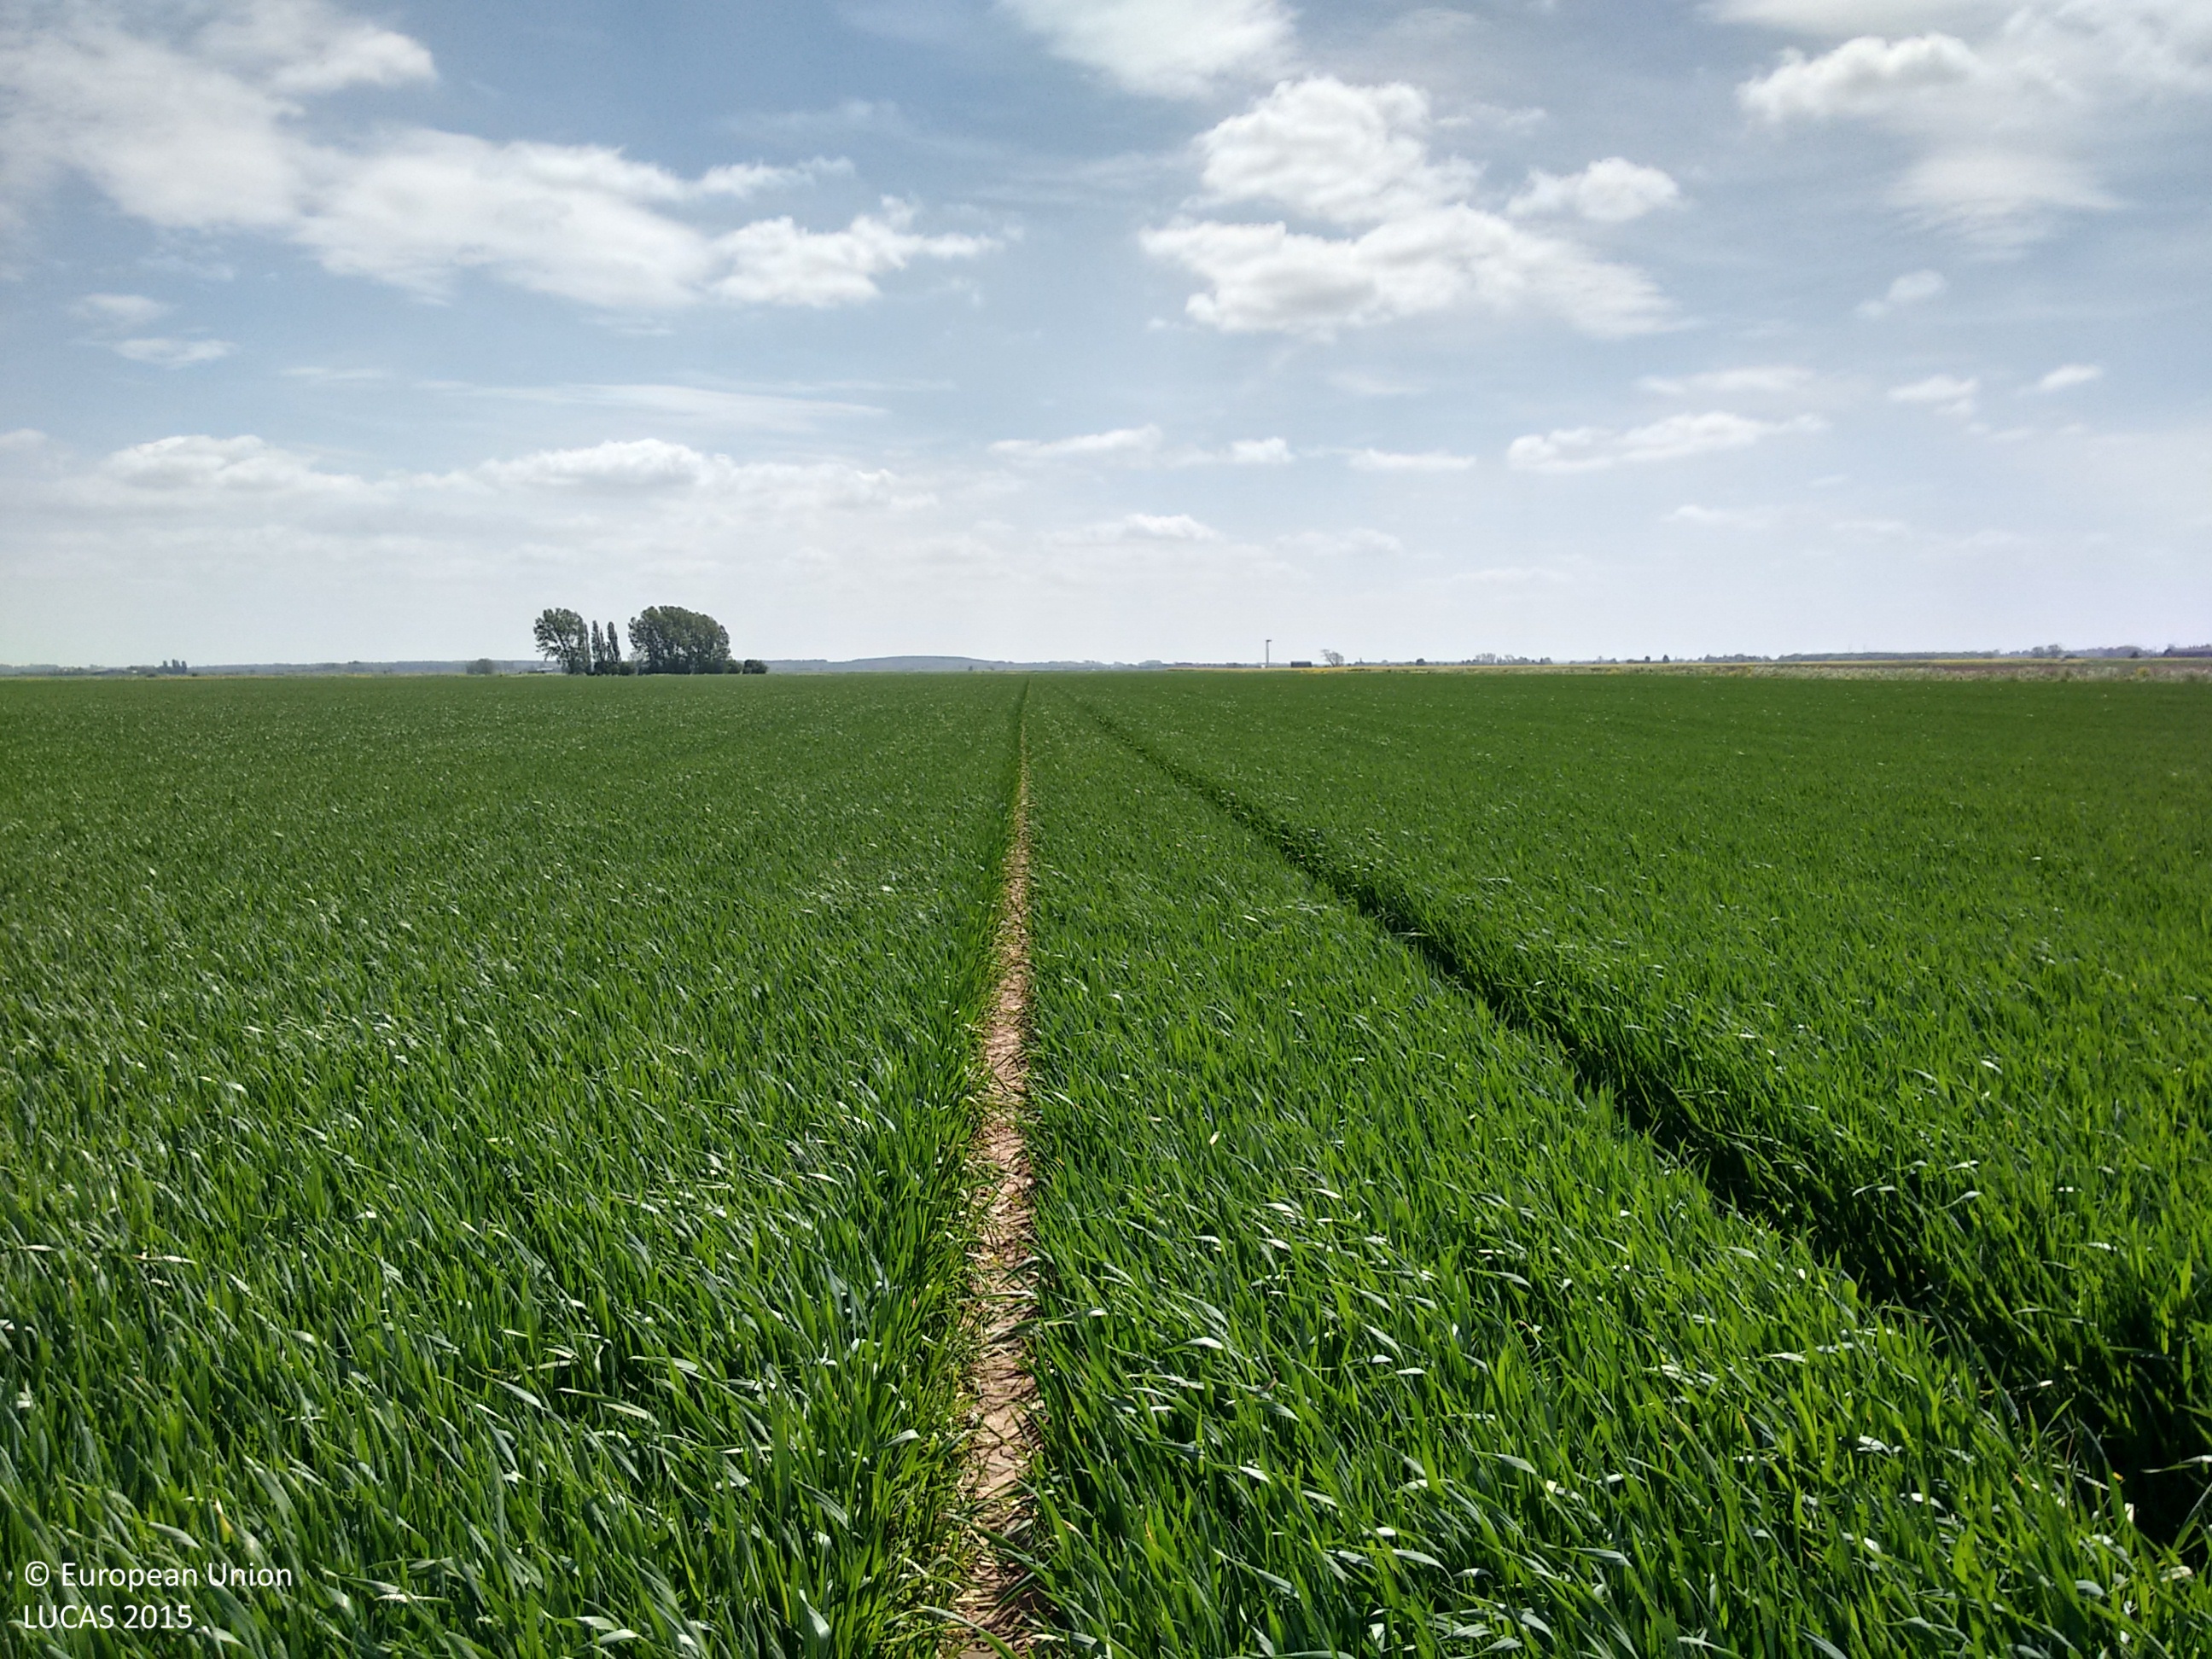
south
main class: Cropland
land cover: Common wheat
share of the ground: > 75 %
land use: Agriculture (excluding fallow land and kitchen gardens)
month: May
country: GB
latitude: 53.5372
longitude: -0.7684
